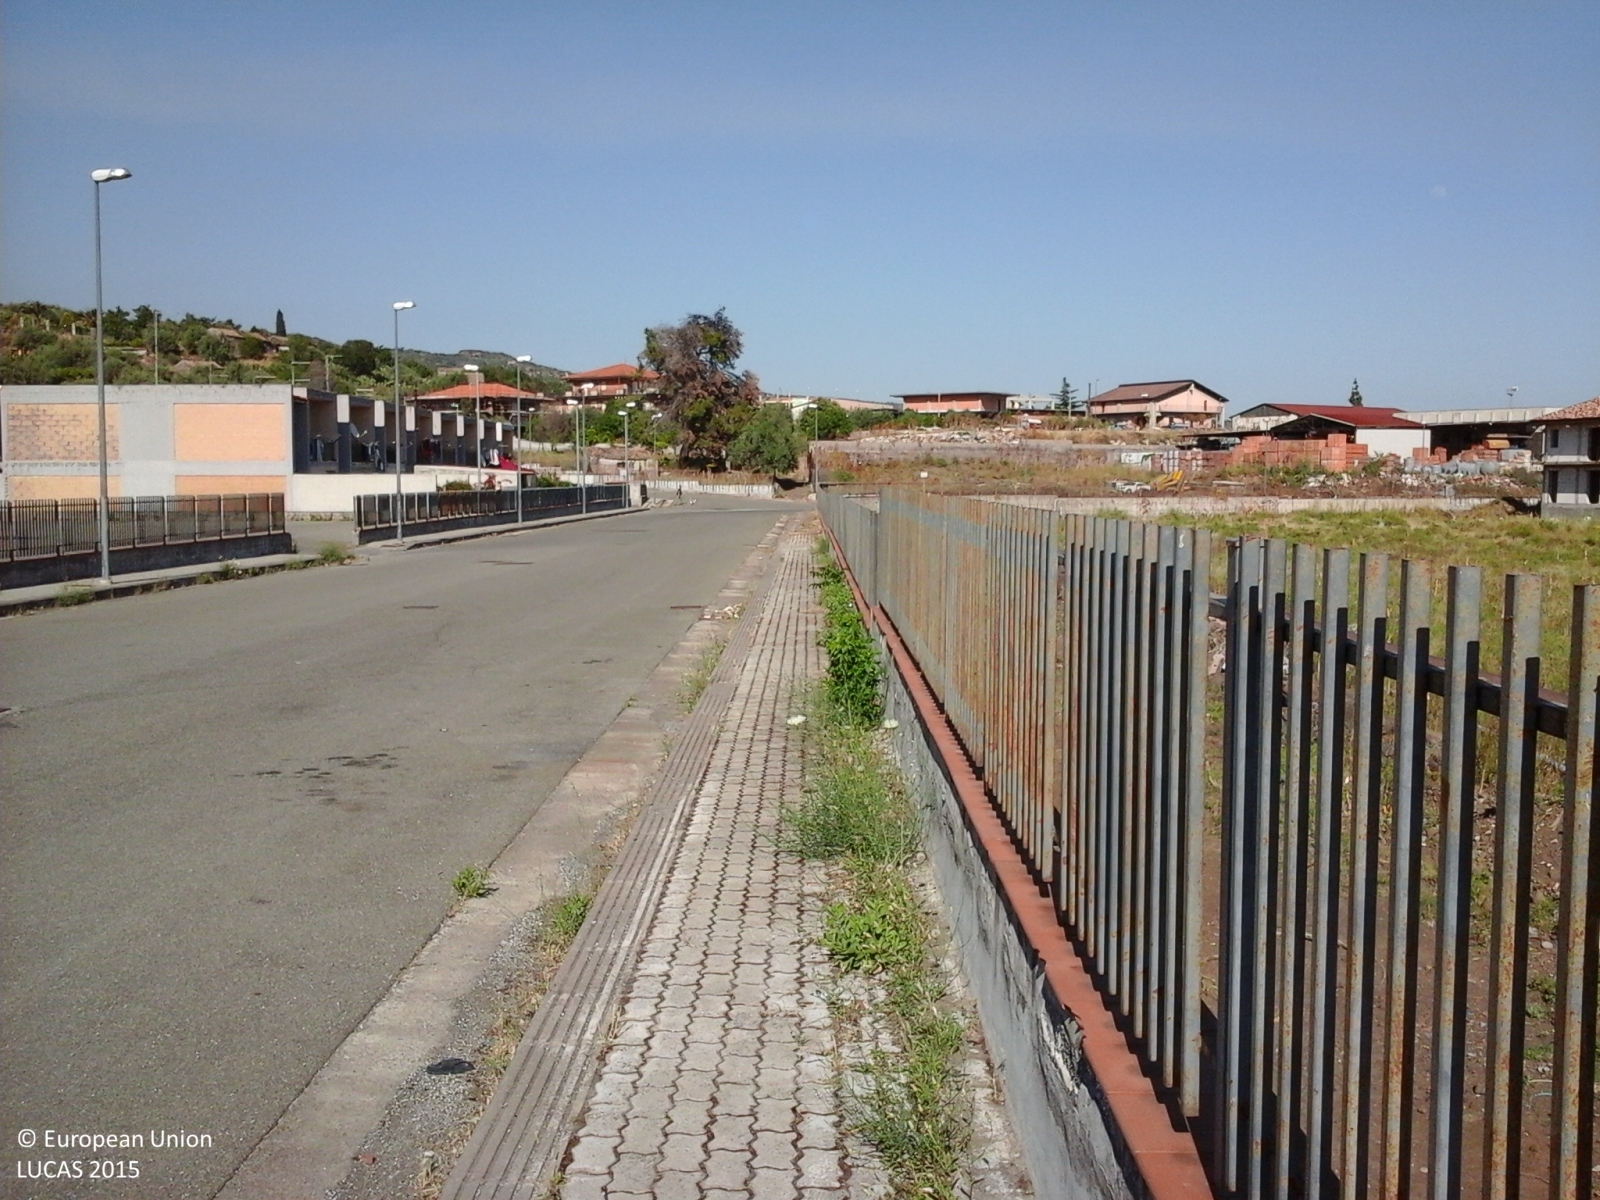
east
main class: Grassland
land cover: Grassland without tree/shrub cover
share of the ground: > 75 %
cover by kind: herbaceous plants 100 %
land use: Abandoned areas
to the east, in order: Grassland without tree/shrub cover; Artificial constructions in urban areas
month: May
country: IT
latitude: 37.6215
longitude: 14.8938
